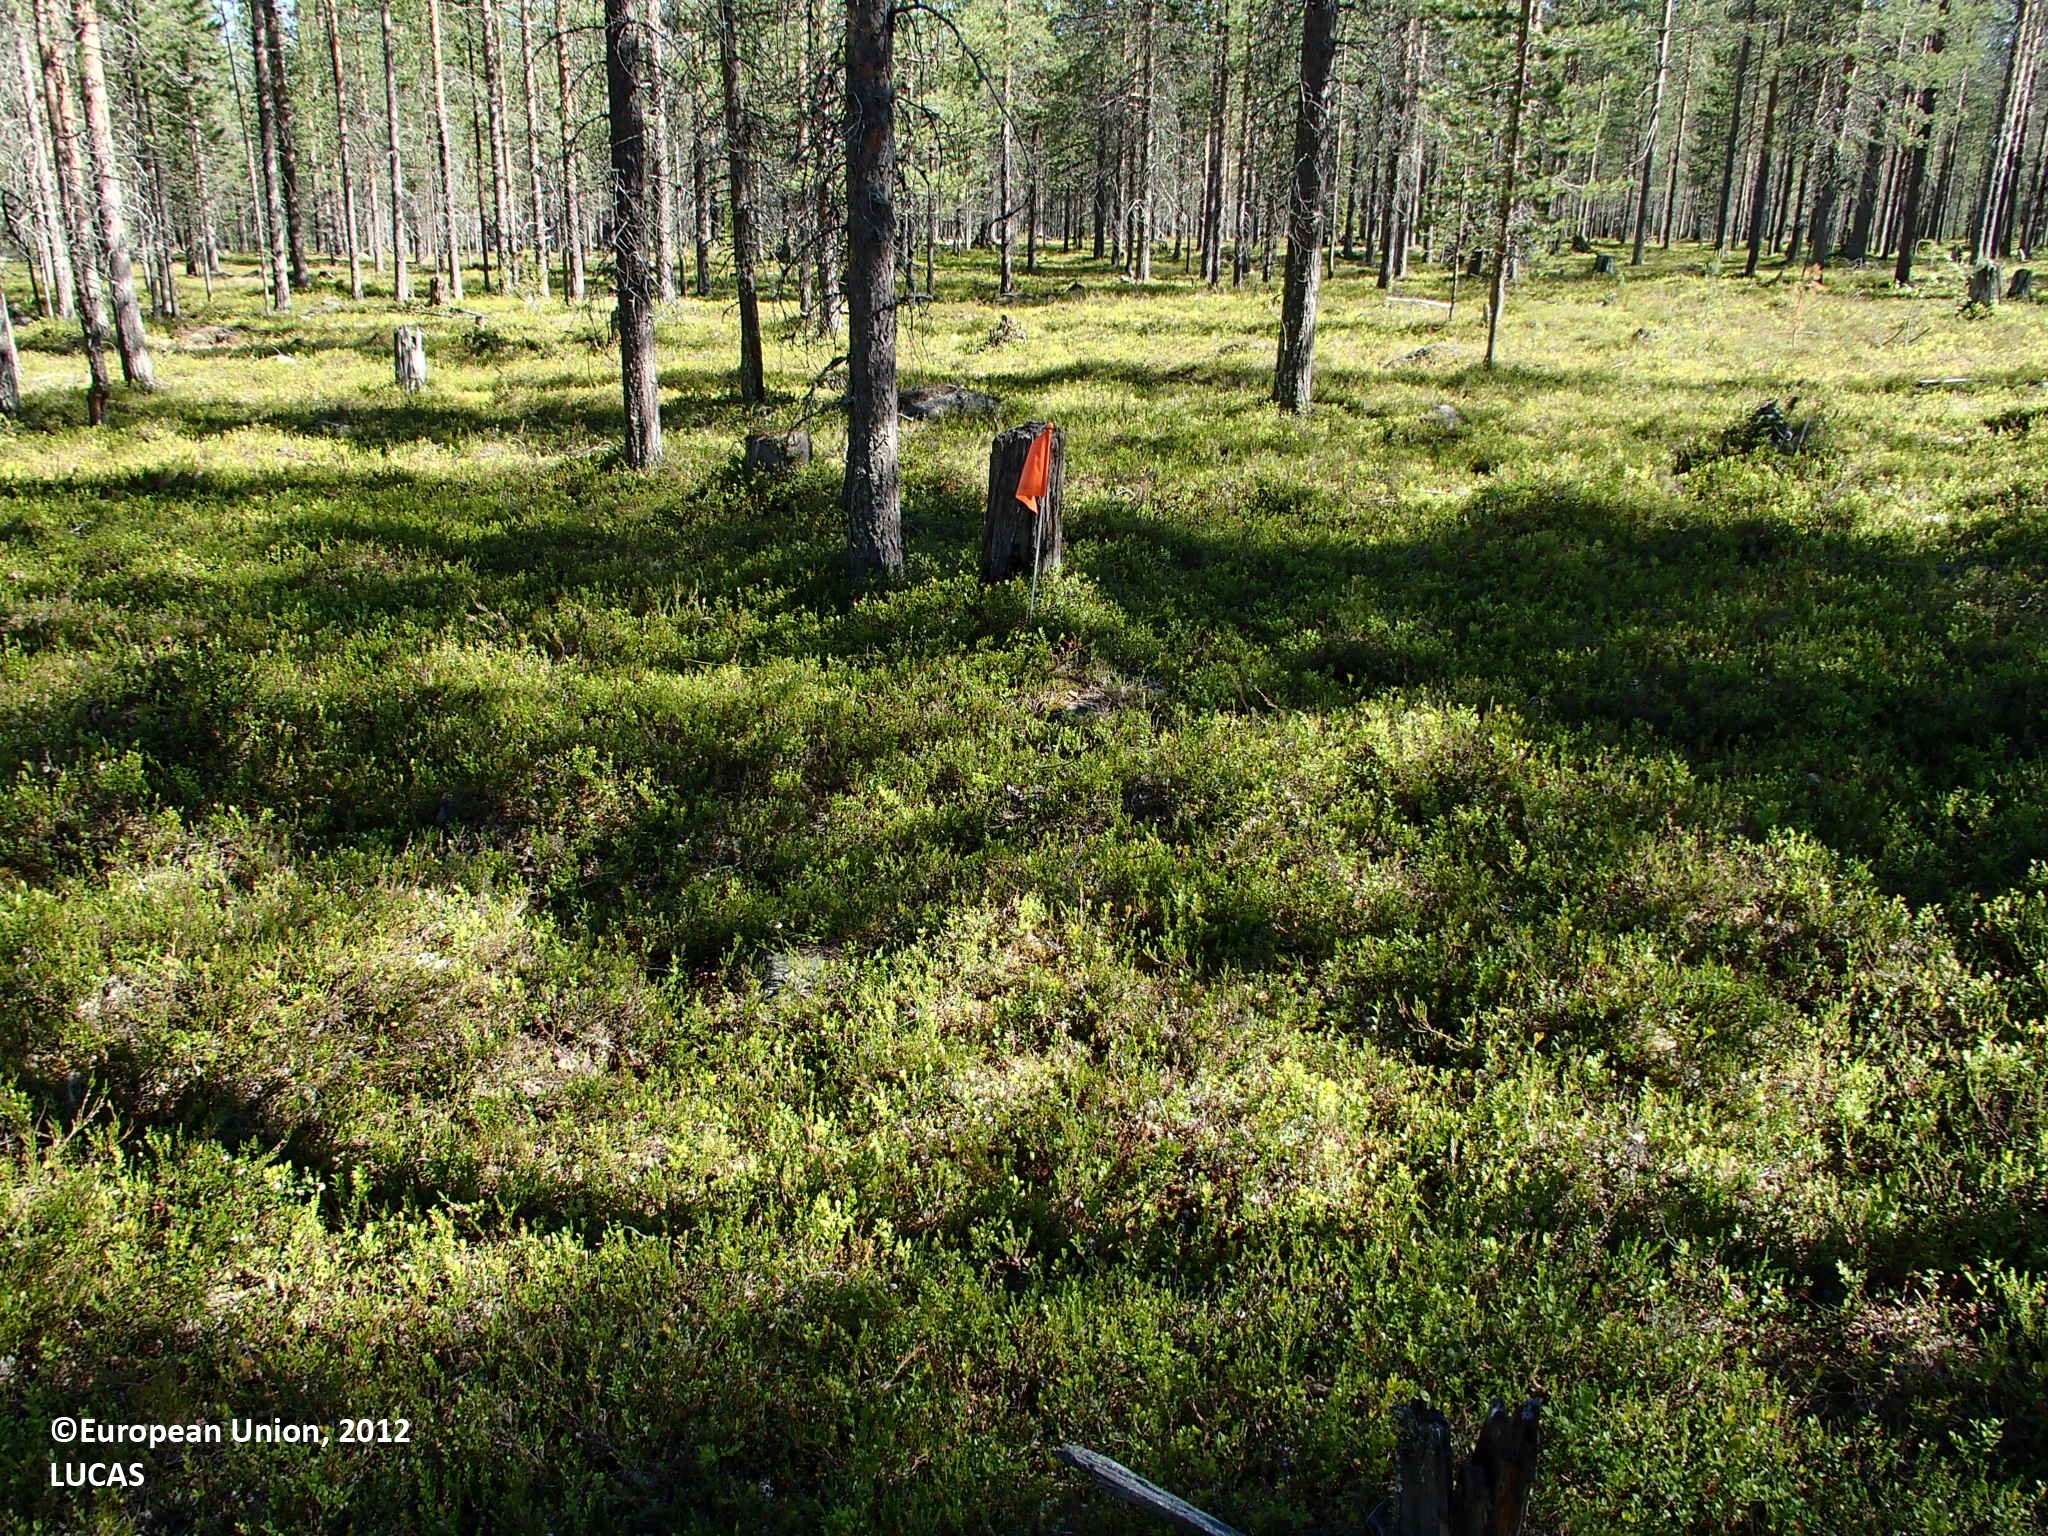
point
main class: Woodland
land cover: Pine dominated coniferous woodland
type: boreal forest
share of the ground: 25 - 50 %
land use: Forestry
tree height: > 5 m
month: July
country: FI
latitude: 67.2027
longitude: 26.7099
